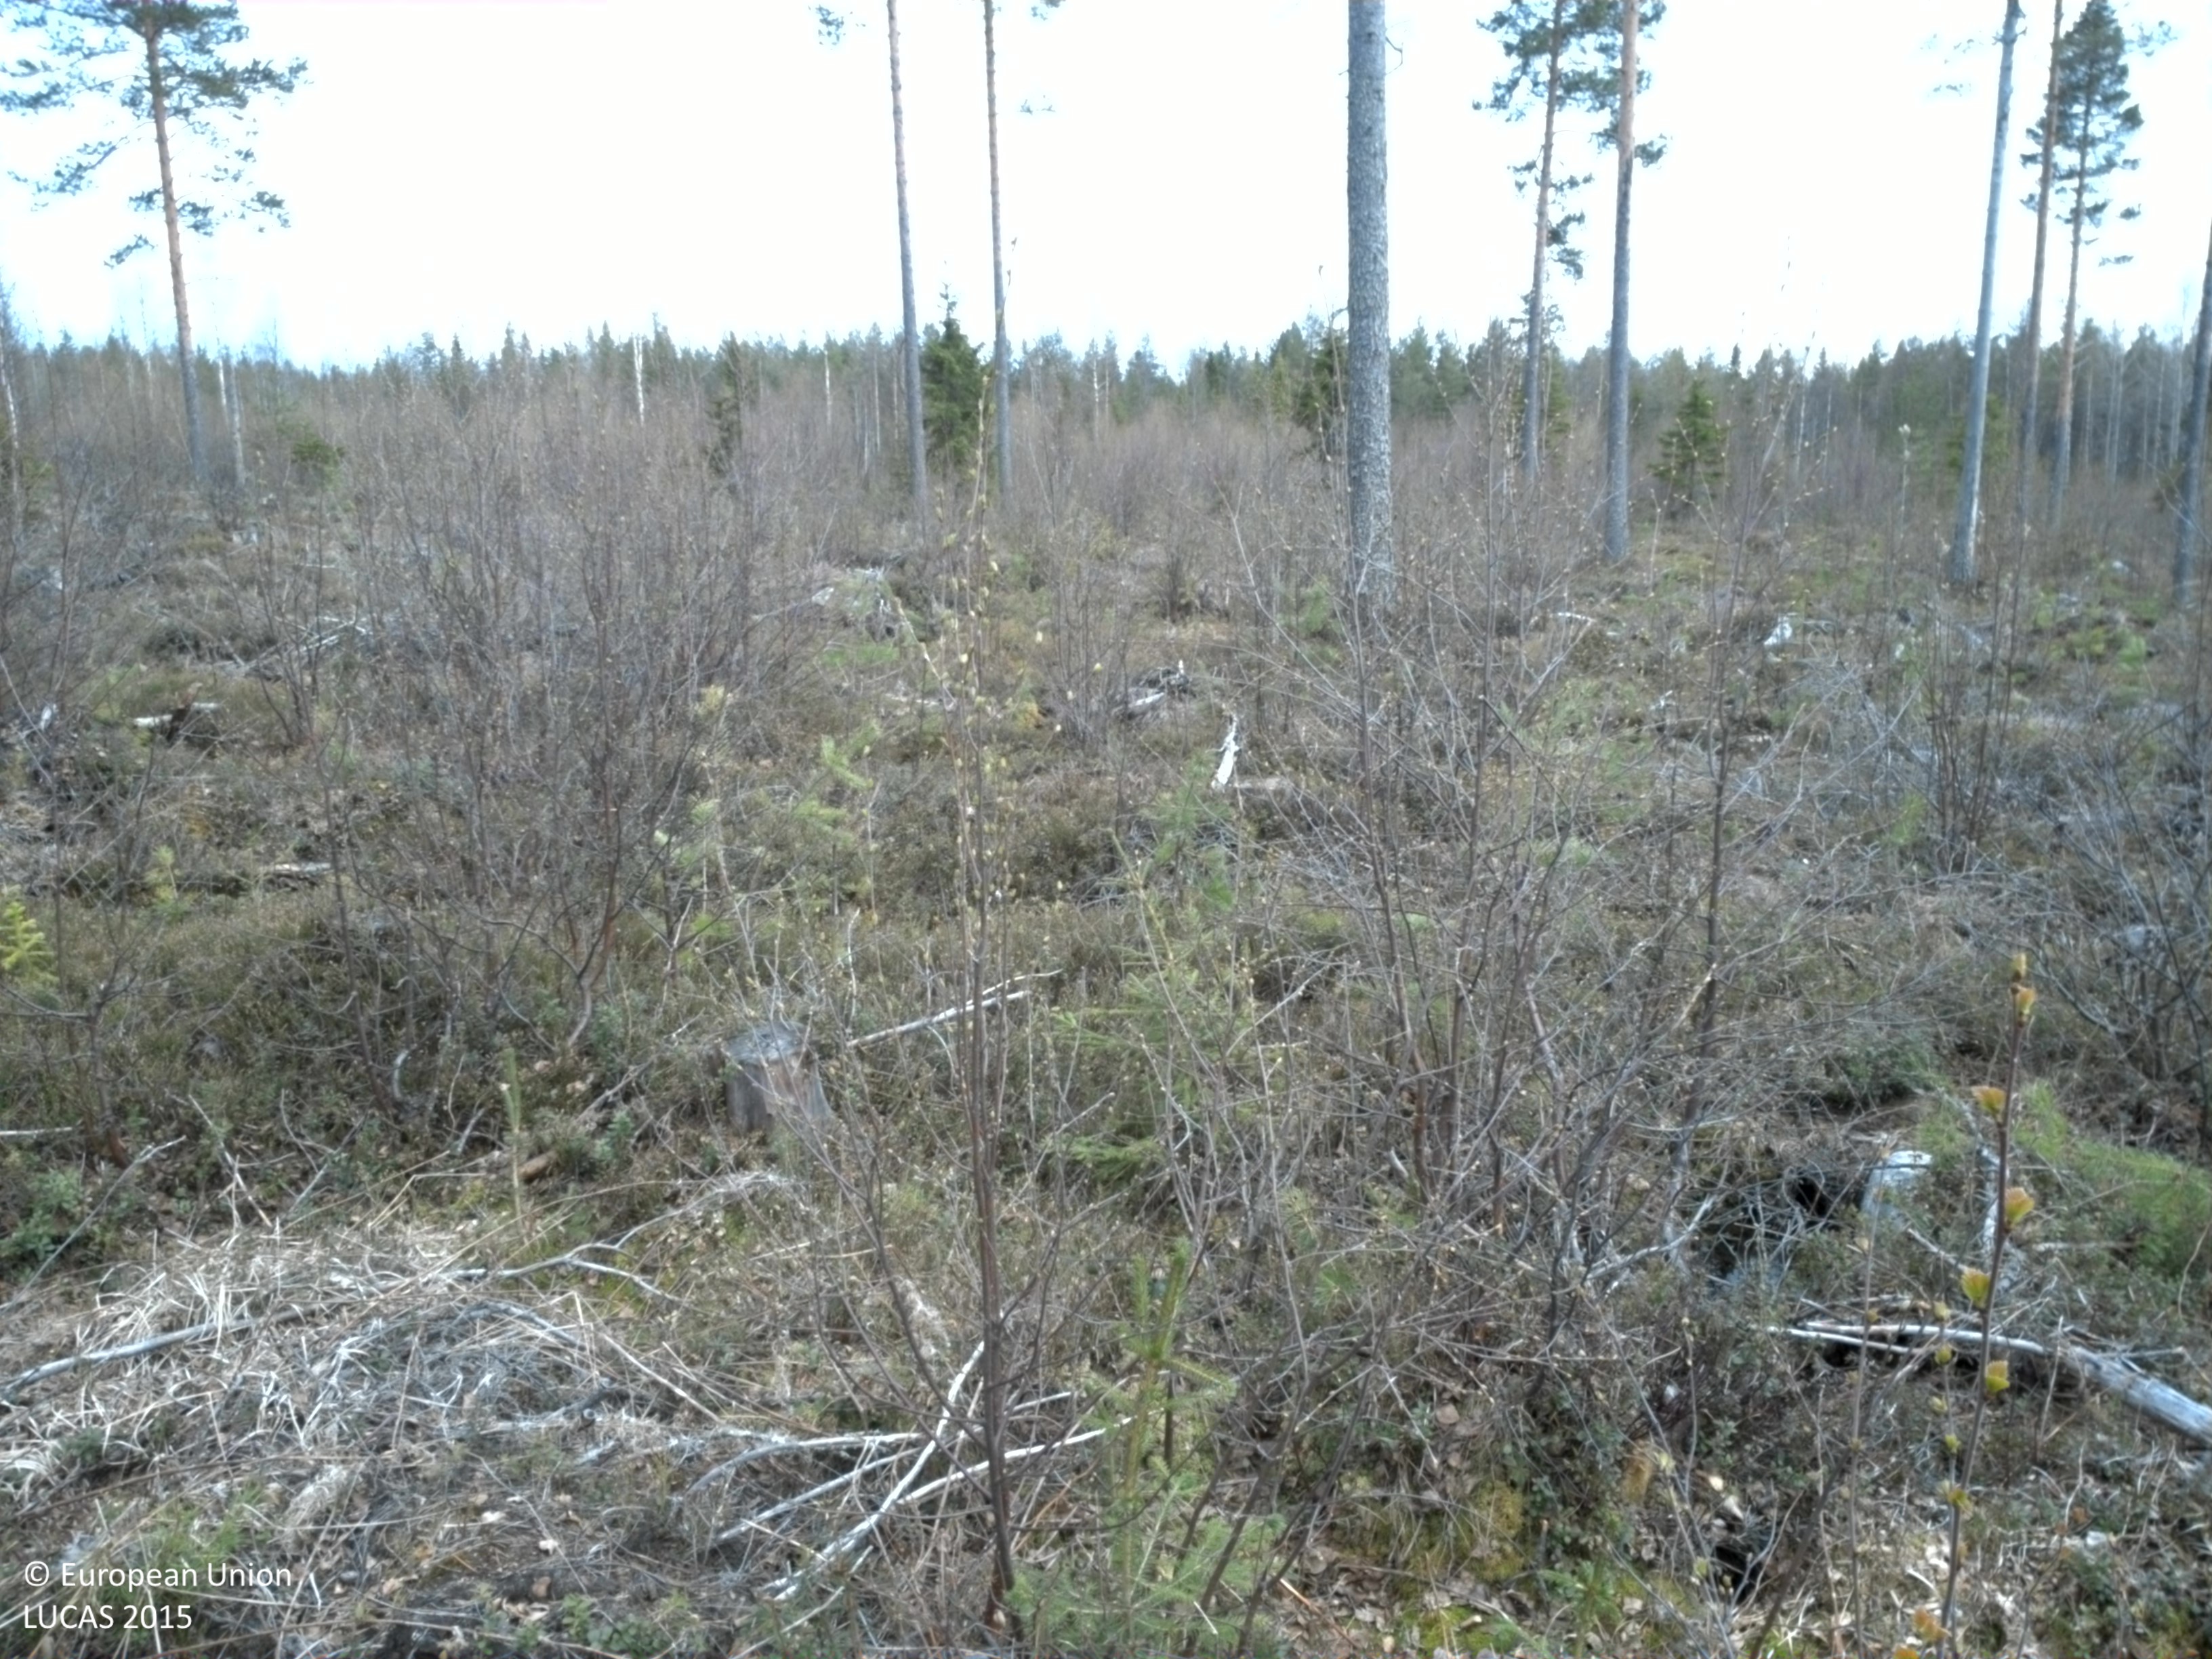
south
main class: Woodland
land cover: Pine dominated mixed woodland
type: boreal forest
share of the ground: 25 - 50 %
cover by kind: shrubs 40 %, coniferous forest trees 30 %, broadleaved forest trees 20 %, herbaceous plants 5 %, lichens and mosses 5 %
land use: Forestry
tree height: < 5 m
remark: Clear cut
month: May
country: SE
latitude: 65.8149
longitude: 22.9136
